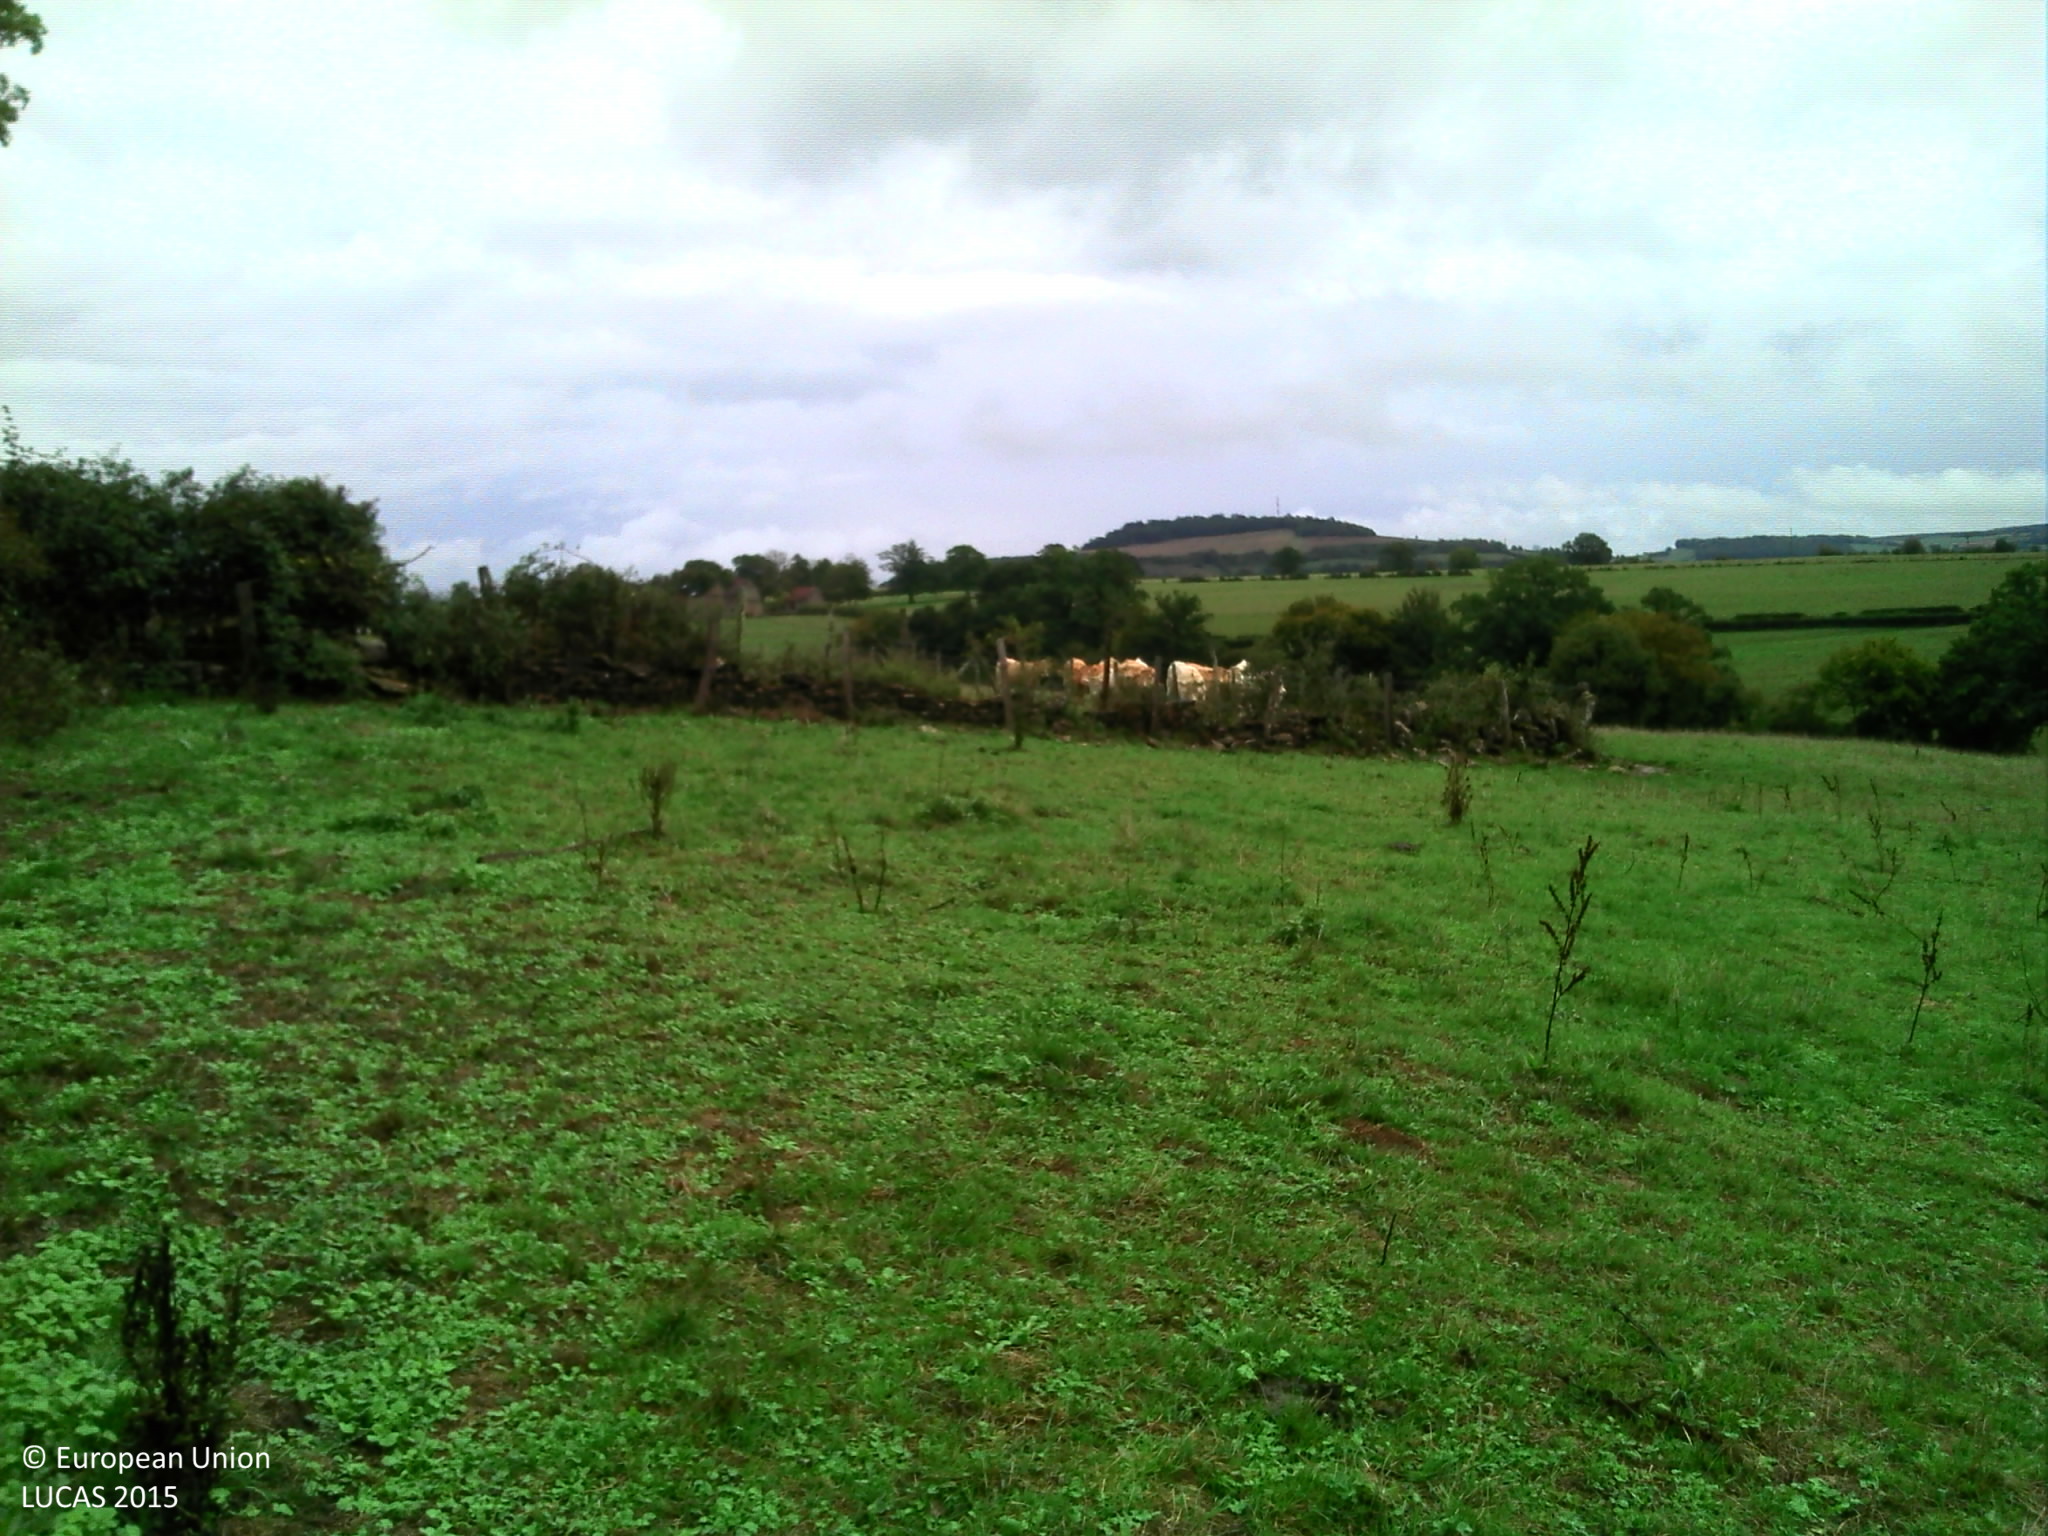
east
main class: Grassland
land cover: Grassland without tree/shrub cover
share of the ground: > 75 %
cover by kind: herbaceous plants 100 %
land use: Agriculture (excluding fallow land and kitchen gardens)
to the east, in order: Grassland without tree/shrub cover; Fences; Managed hedges; Fences; Grassland without tree/shrub cover; Fences; Grassland without tree/shrub cover
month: September
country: FR
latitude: 47.3554
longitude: 4.3194
